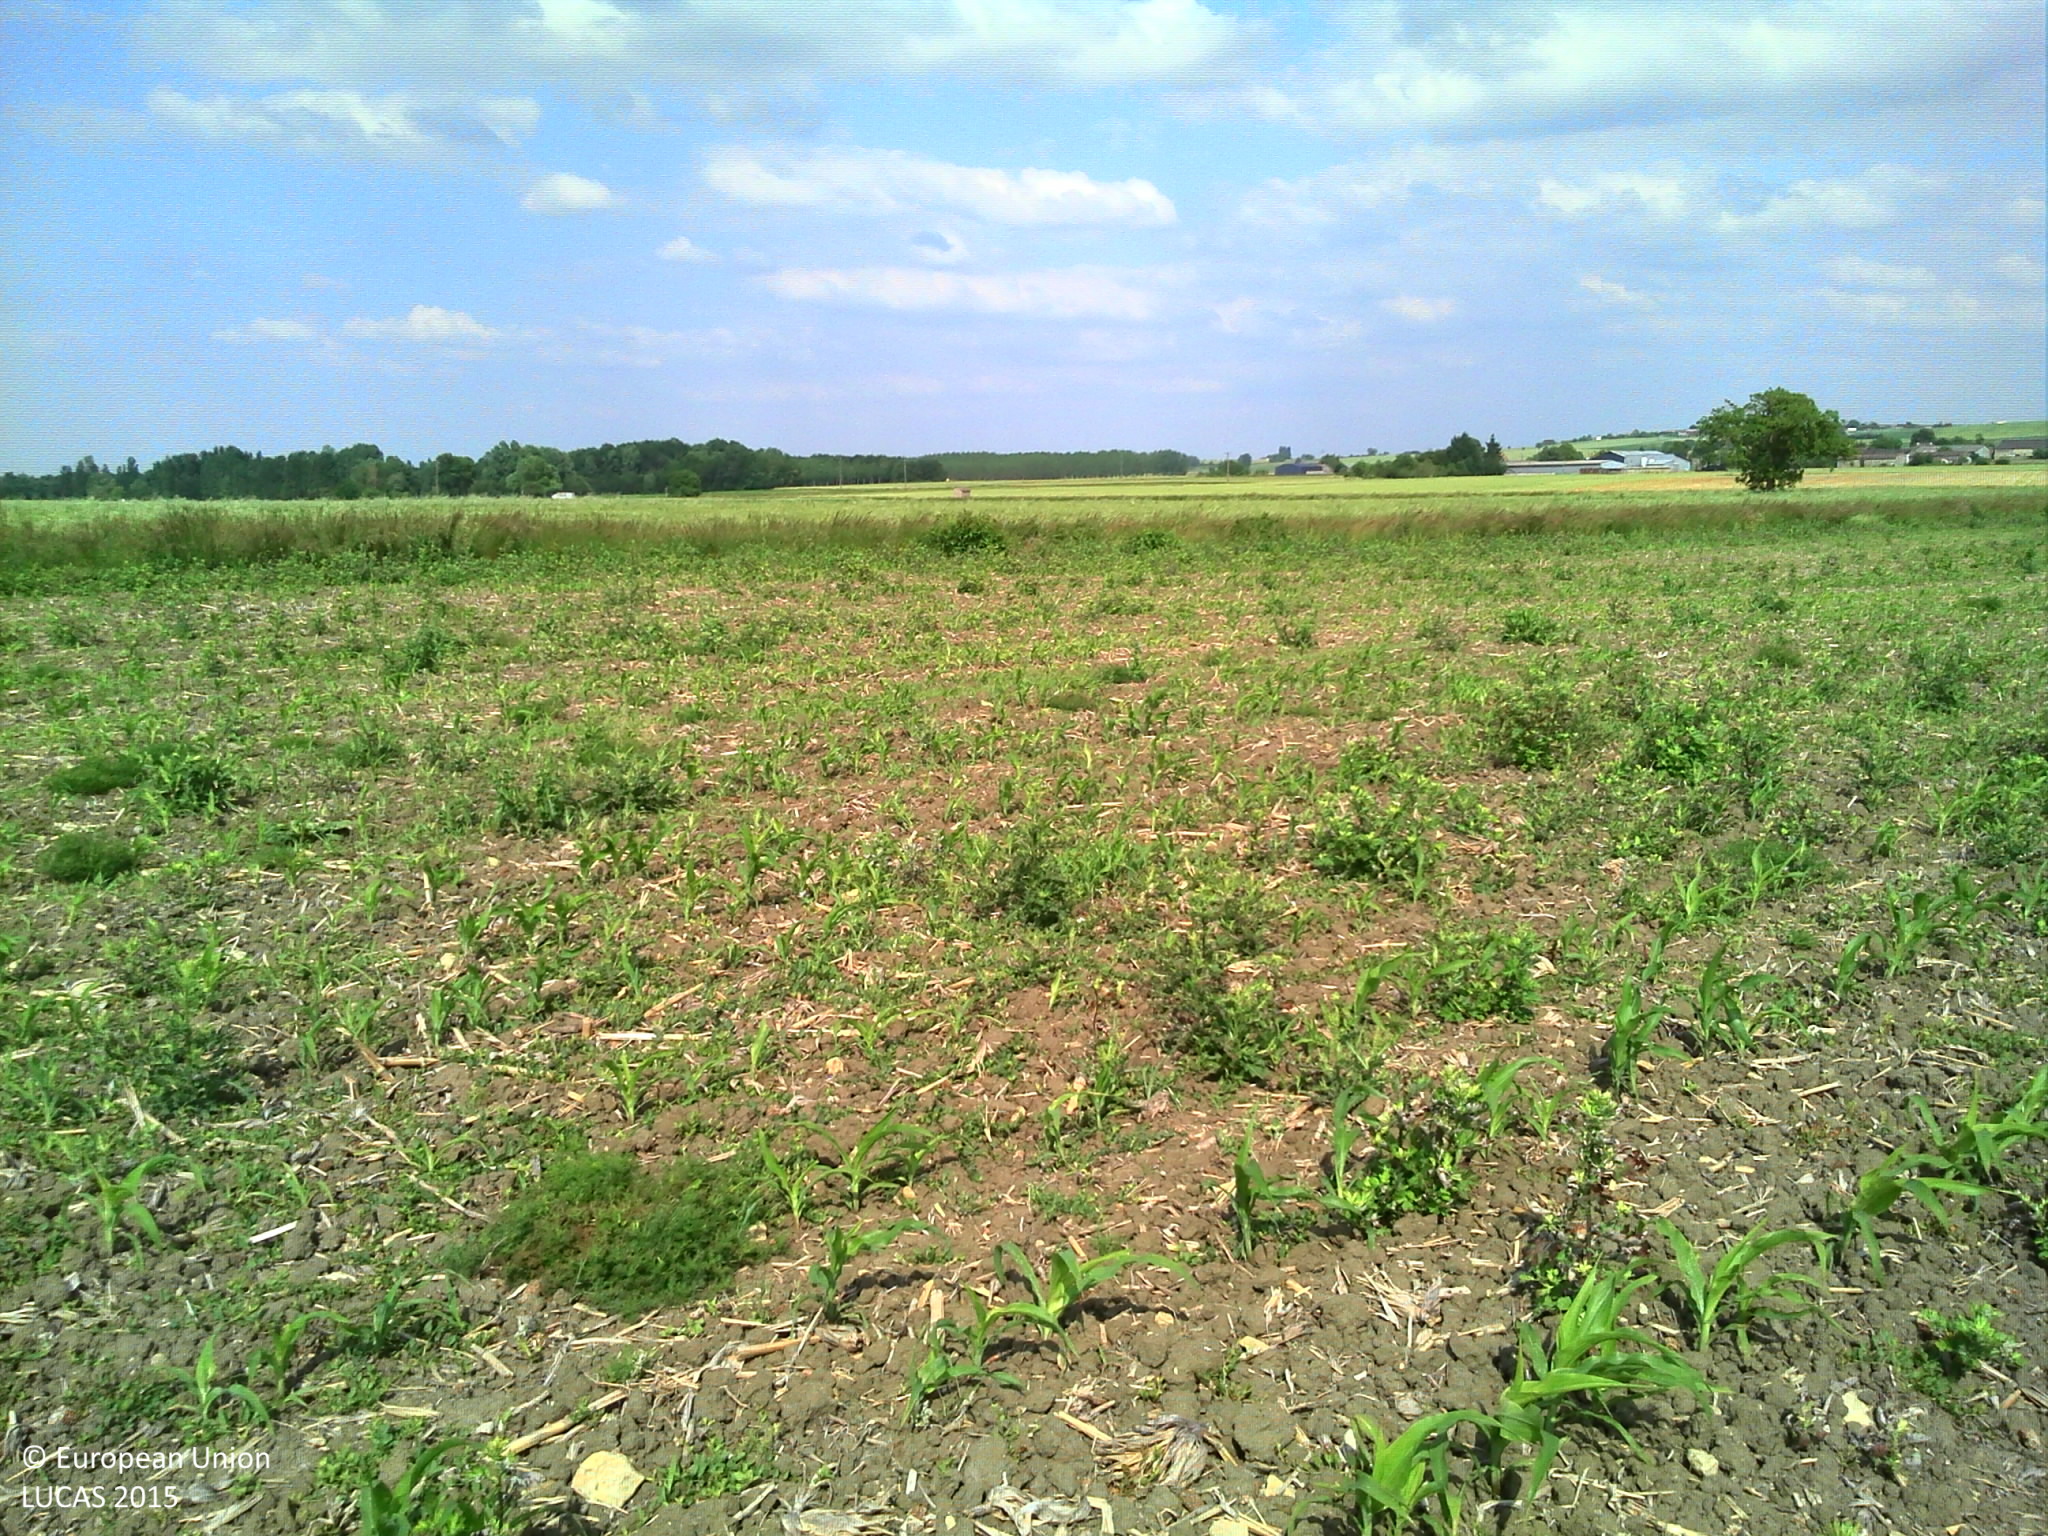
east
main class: Cropland
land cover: Common wheat
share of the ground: > 75 %
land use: Agriculture (excluding fallow land and kitchen gardens)
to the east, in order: Common wheat; Maize; Grass margins; Ditches and canals; Grass margins; Tracks; Grass margins; Ditches and canals; Grass margins; Common wheat; Other leguminous and mixtures for fodder
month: June
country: FR
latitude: 46.8595
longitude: 0.1800
